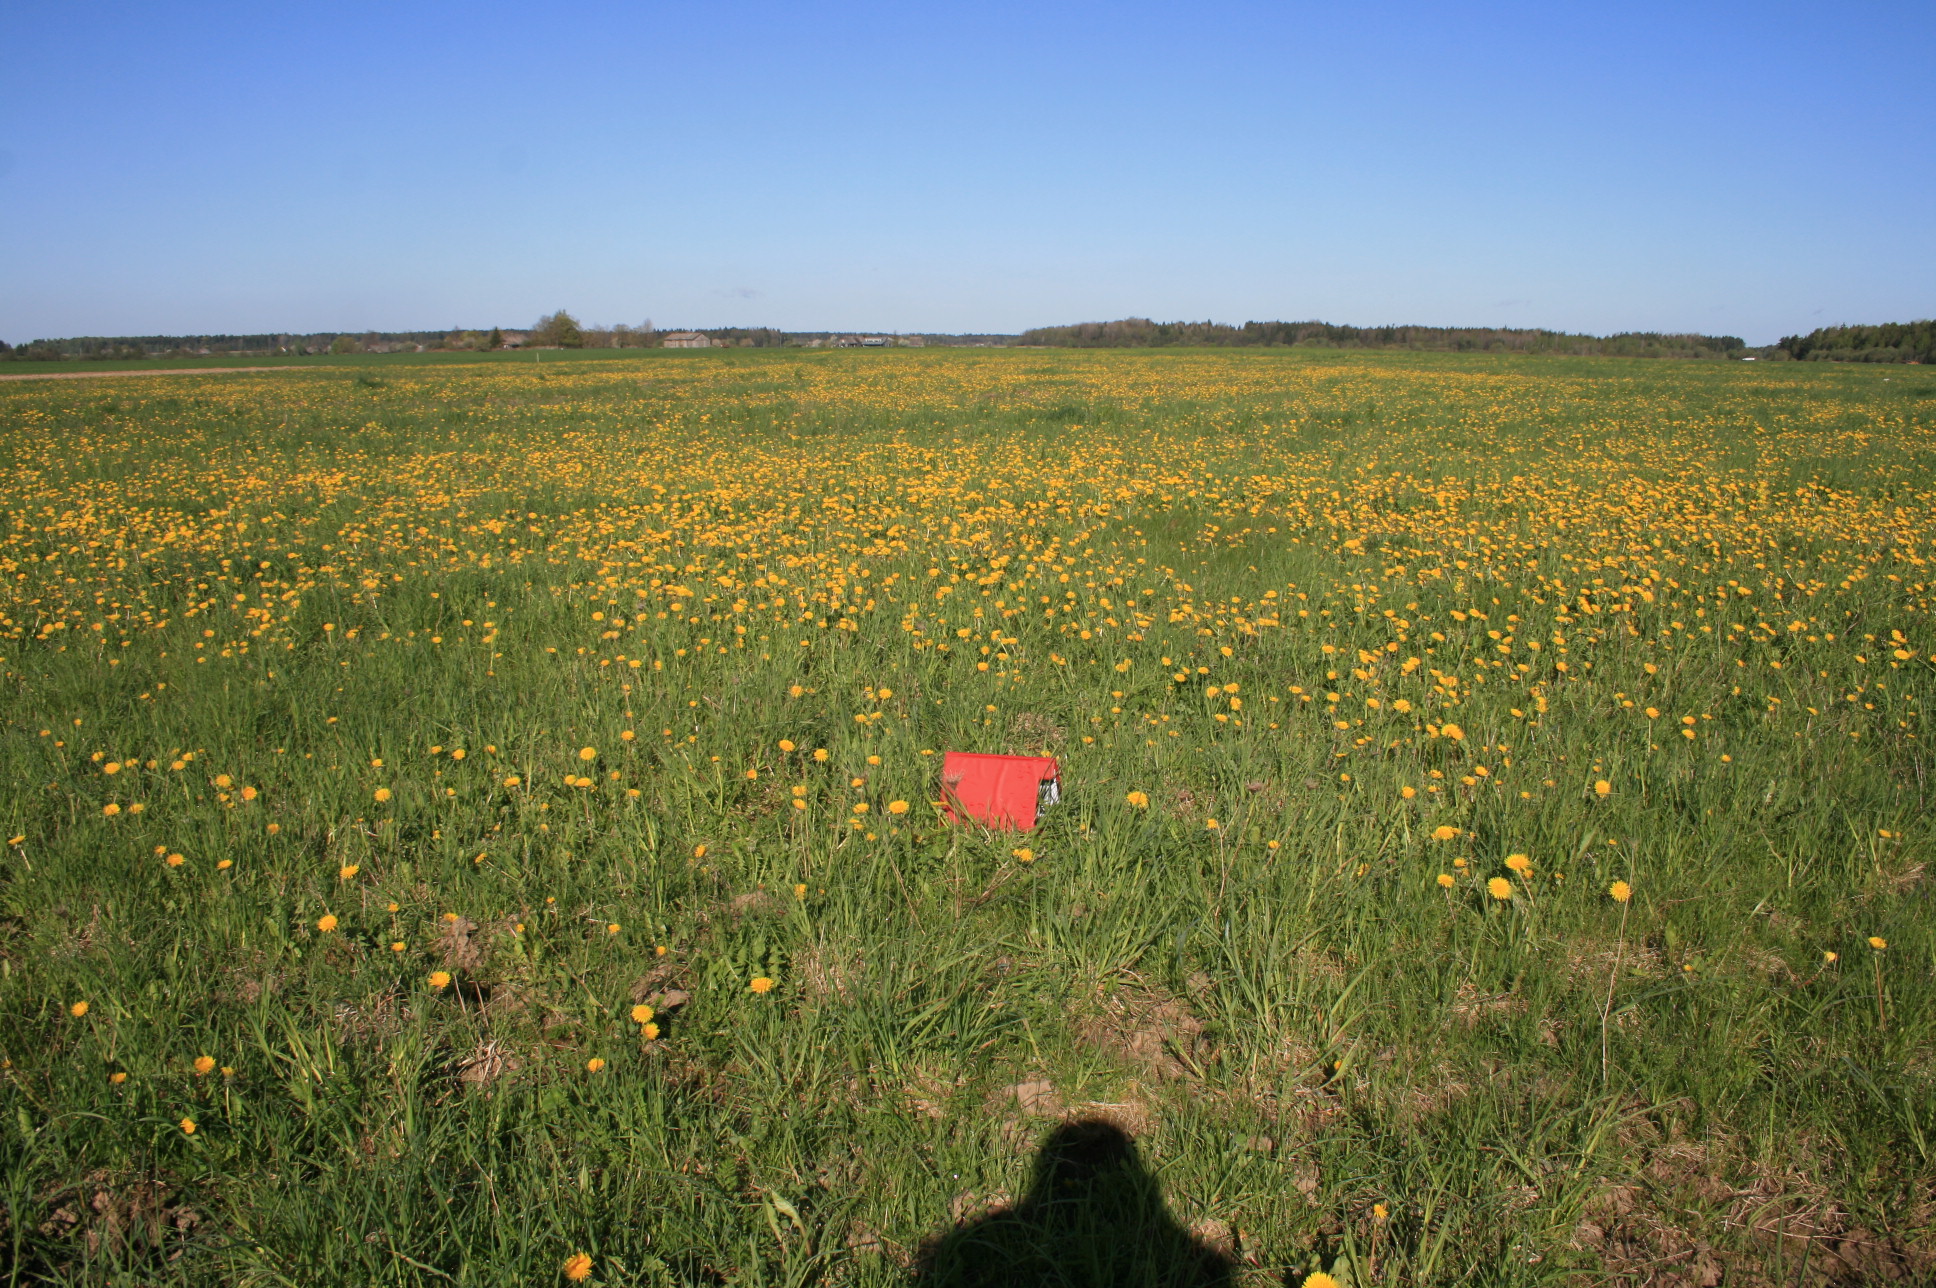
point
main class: Grassland
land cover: Grassland without tree/shrub cover
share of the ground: > 75 %
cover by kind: herbaceous plants 95 %, lichens and mosses 5 %
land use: Agriculture (excluding fallow land and kitchen gardens)
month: May
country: LT
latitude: 56.1045
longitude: 21.5076
